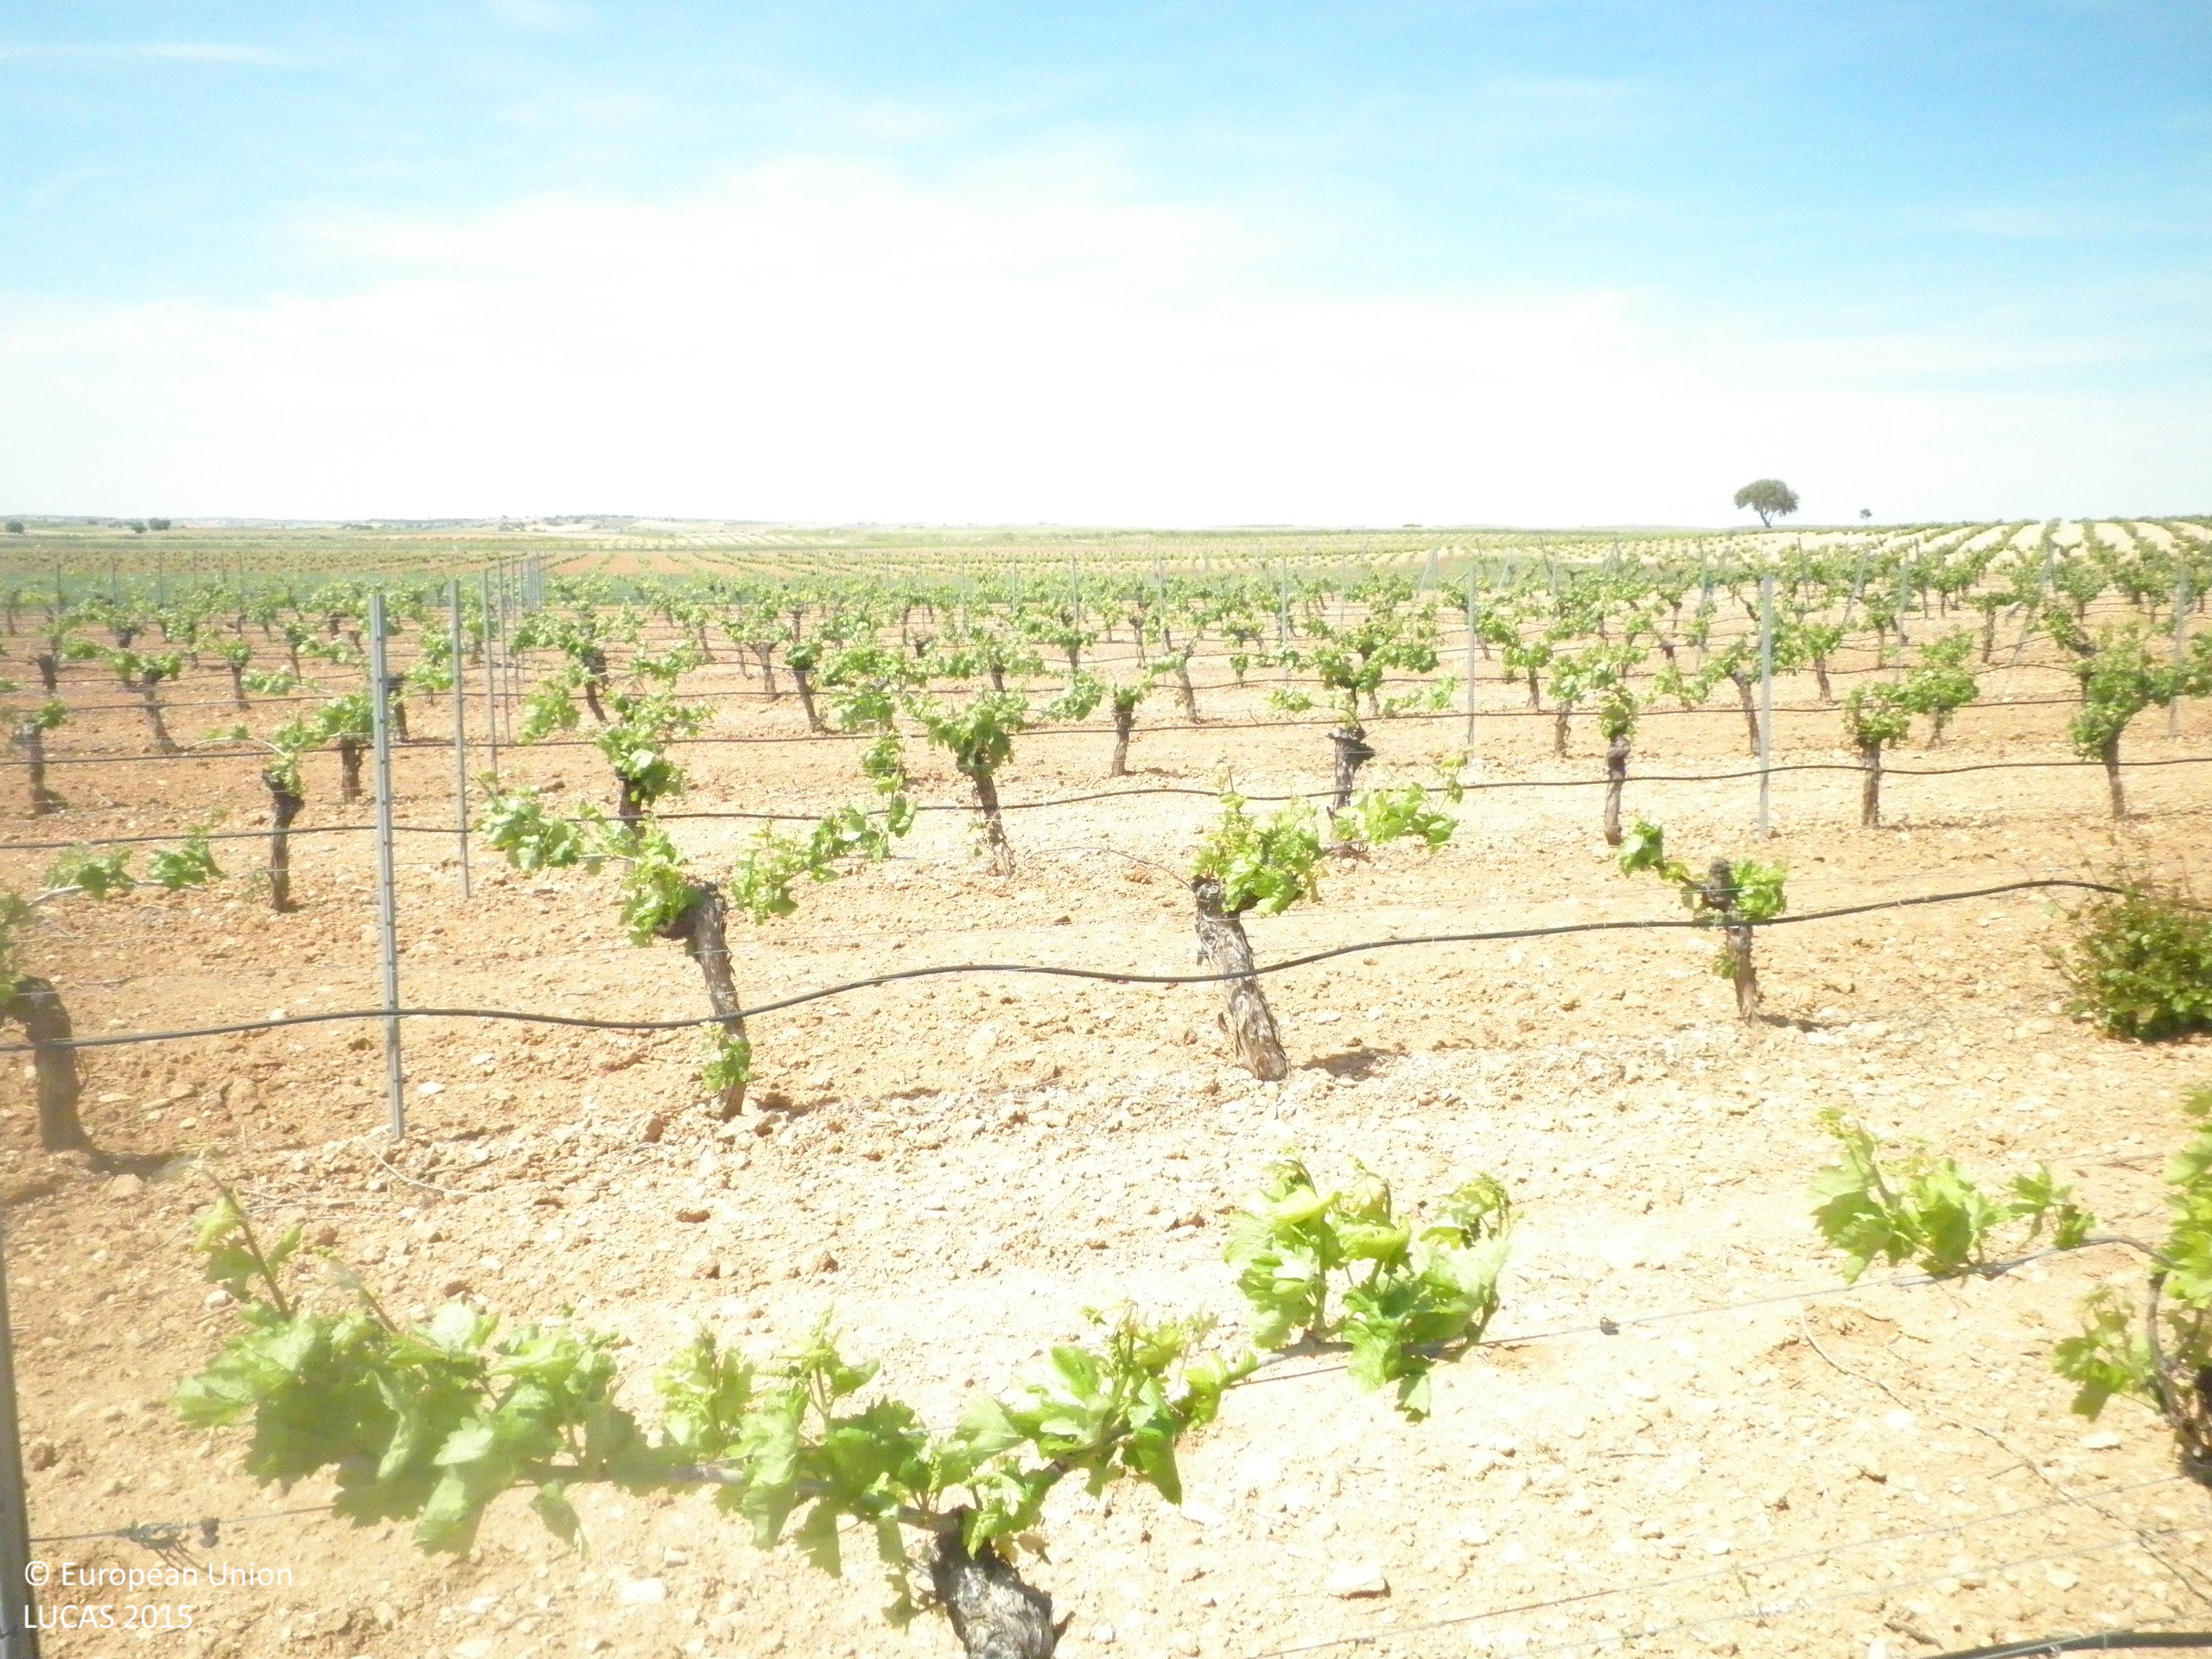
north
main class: Cropland
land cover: Vineyards
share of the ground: < 10 %
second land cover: Other bare soil
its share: > 75 %
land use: Agriculture (excluding fallow land and kitchen gardens)
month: May
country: ES
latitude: 39.5555
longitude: -2.7827
